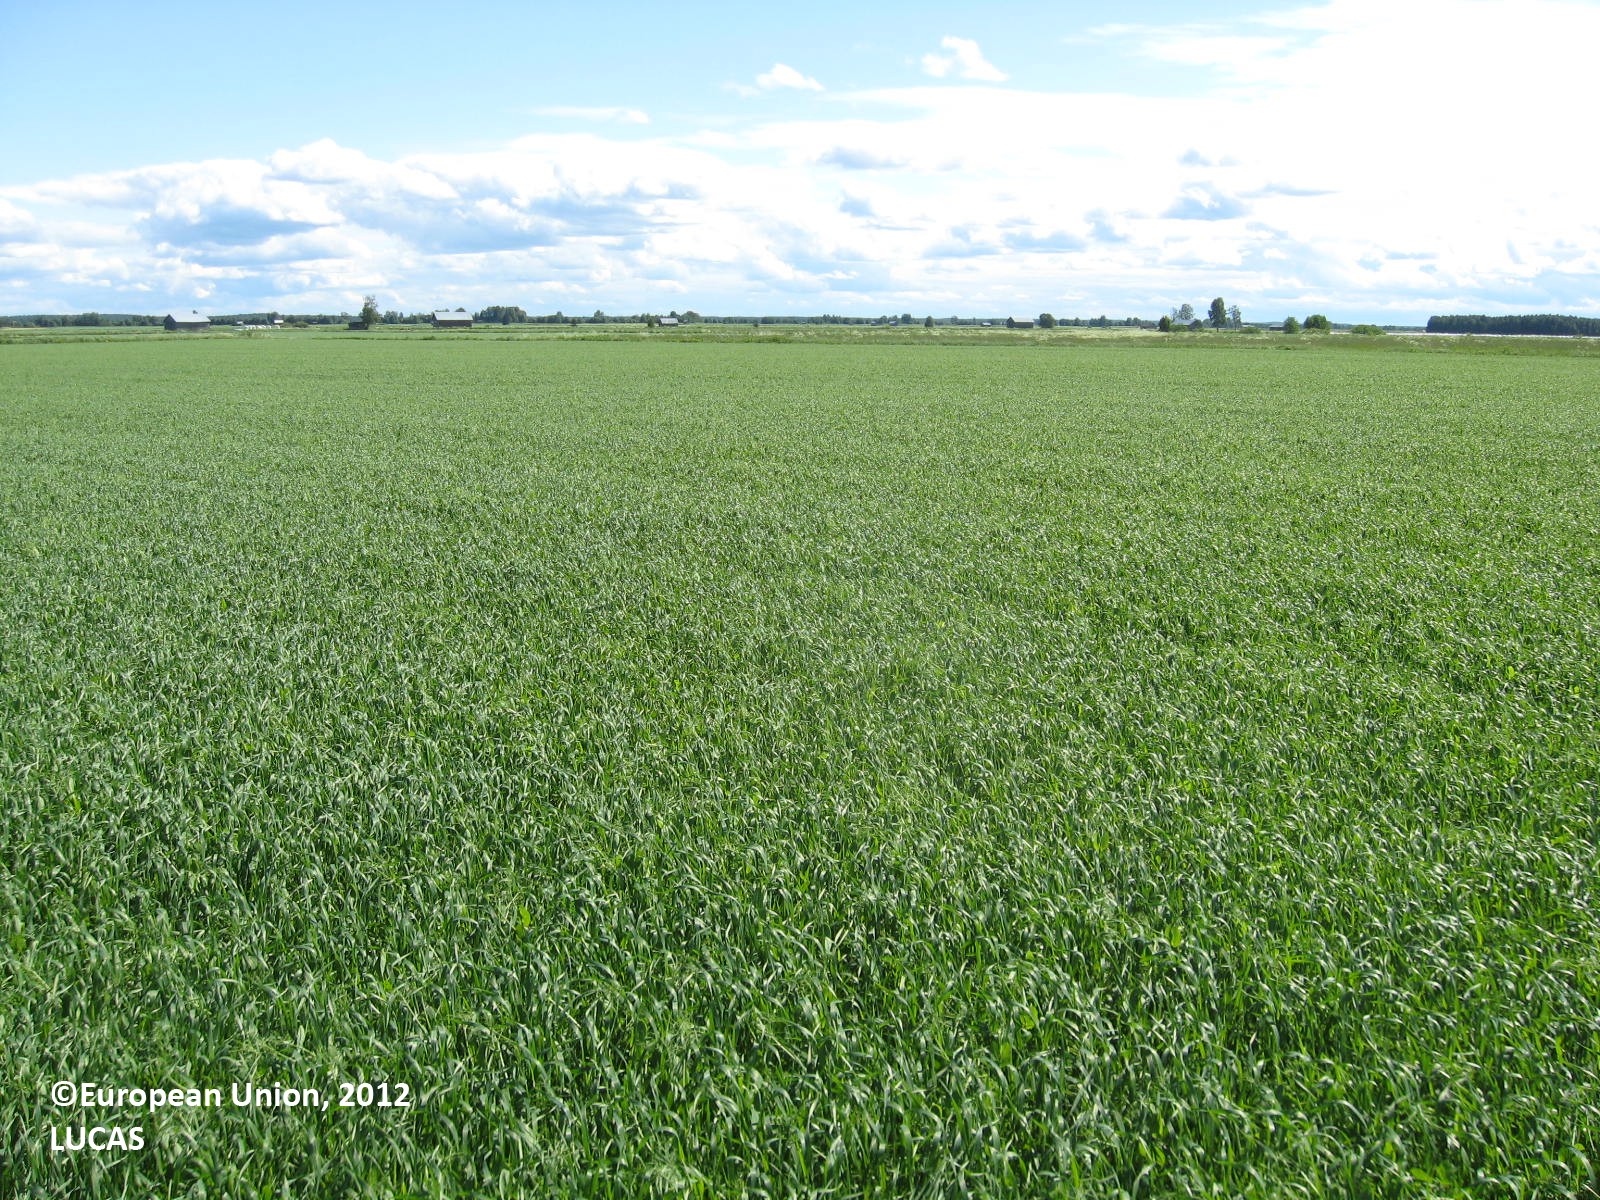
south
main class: Cropland
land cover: Temporary grasslands
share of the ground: > 75 %
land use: Agriculture (excluding fallow land and kitchen gardens)
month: June
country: FI
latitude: 62.8103
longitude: 22.6292
